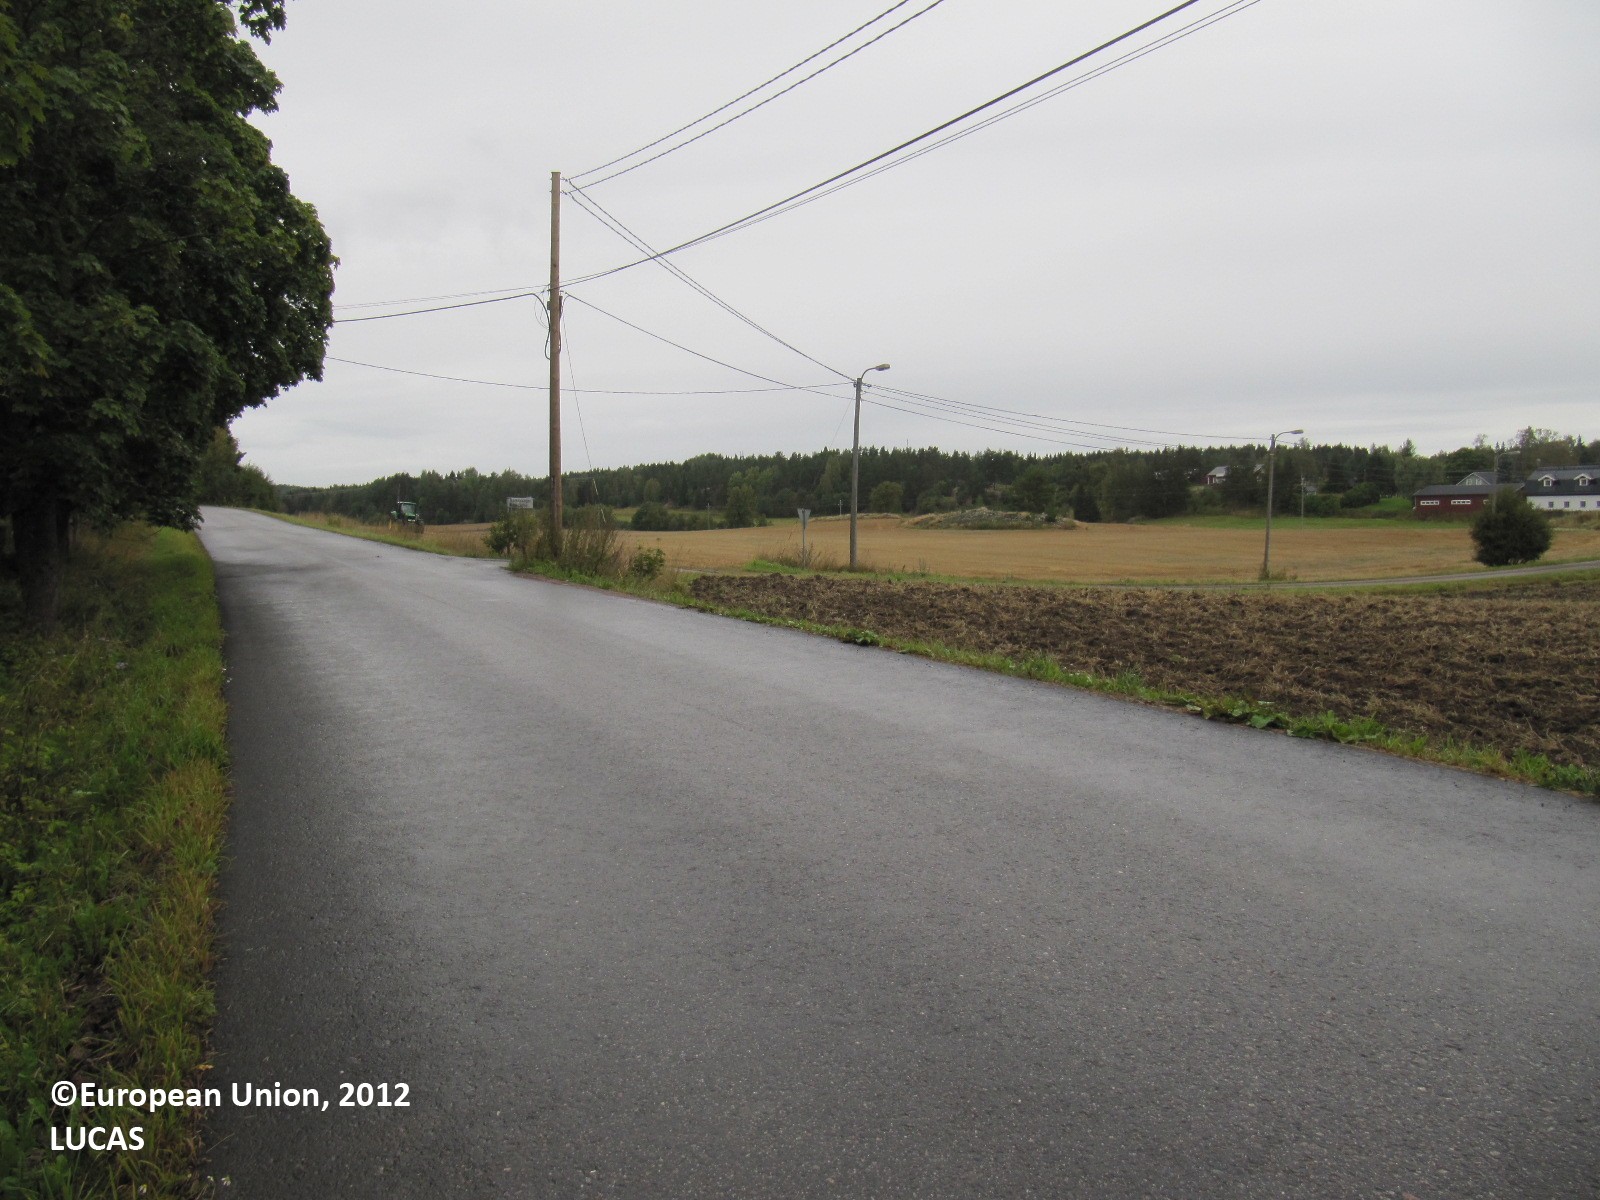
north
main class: Grassland
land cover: Grassland with sparse tree/shrub cover
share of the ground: > 75 %
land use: Residential
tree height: > 5 m
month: September
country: FI
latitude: 60.0724
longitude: 24.0992
